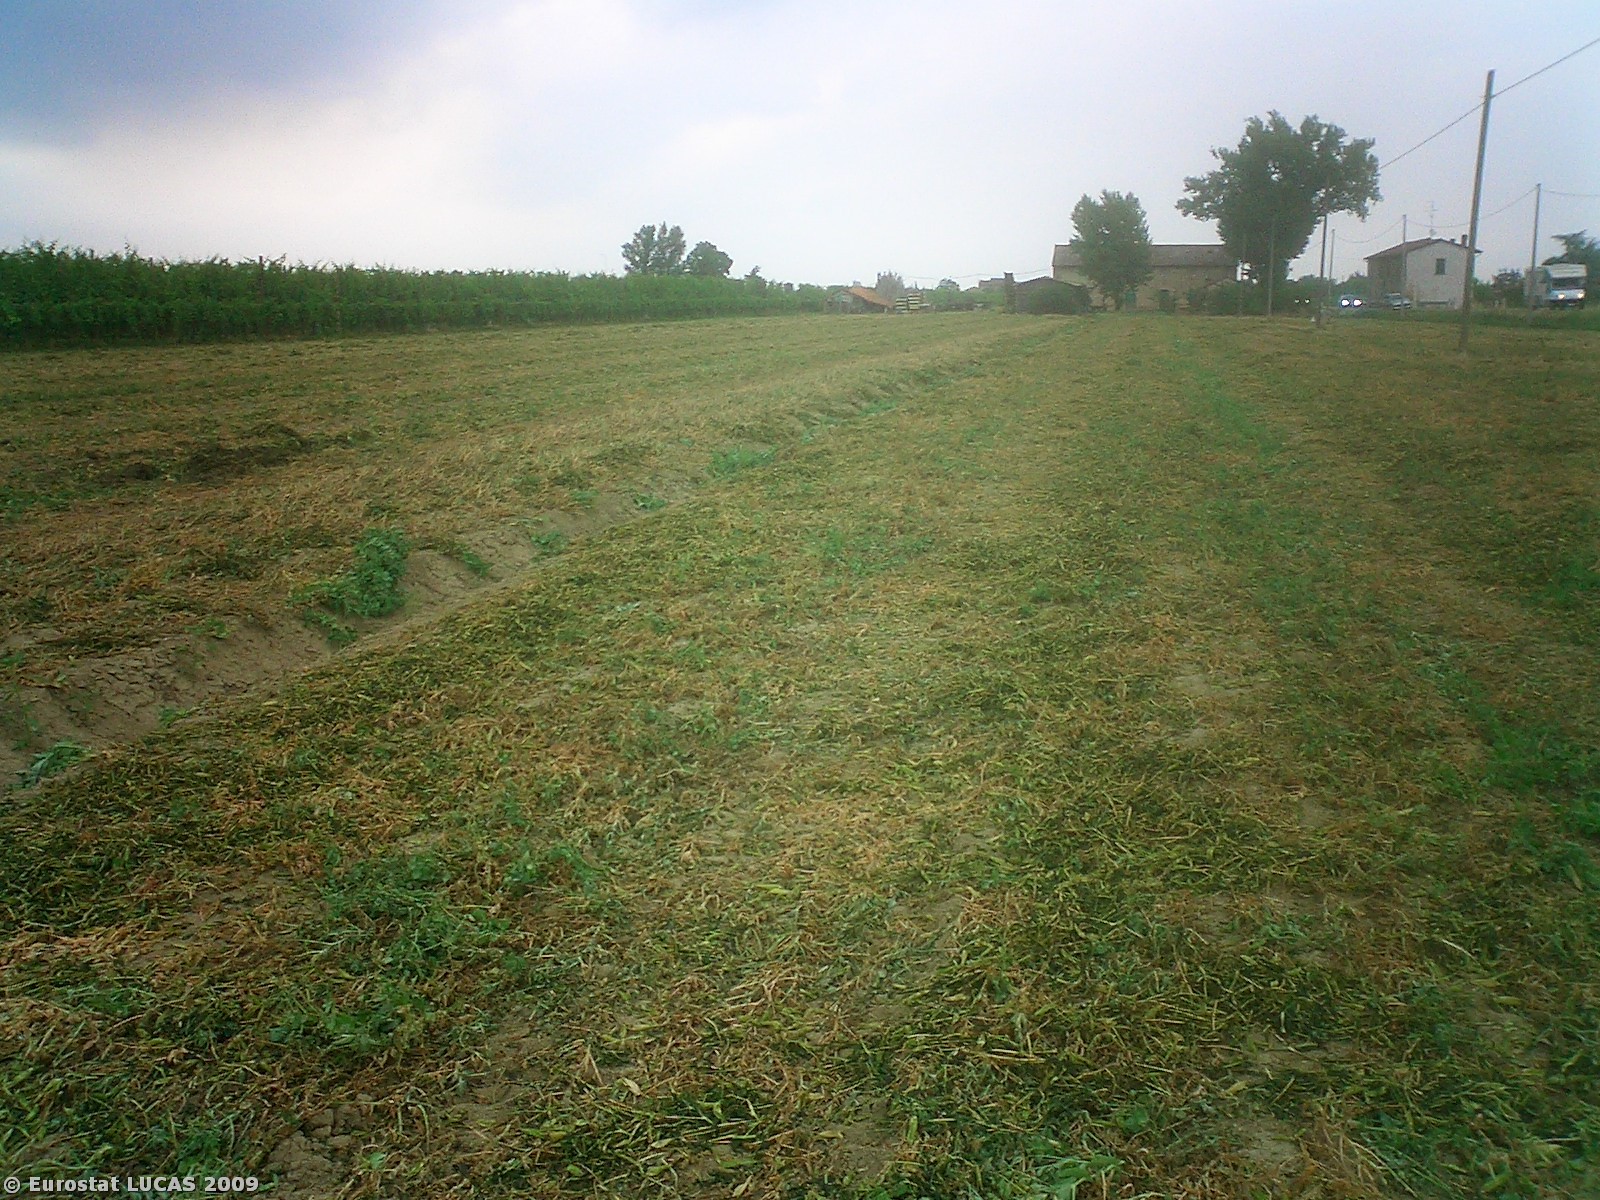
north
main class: Cropland
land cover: Dry pulses
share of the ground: > 75 %
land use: Agriculture (excluding fallow land and kitchen gardens)
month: June
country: IT
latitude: 44.4240
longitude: 11.8675
